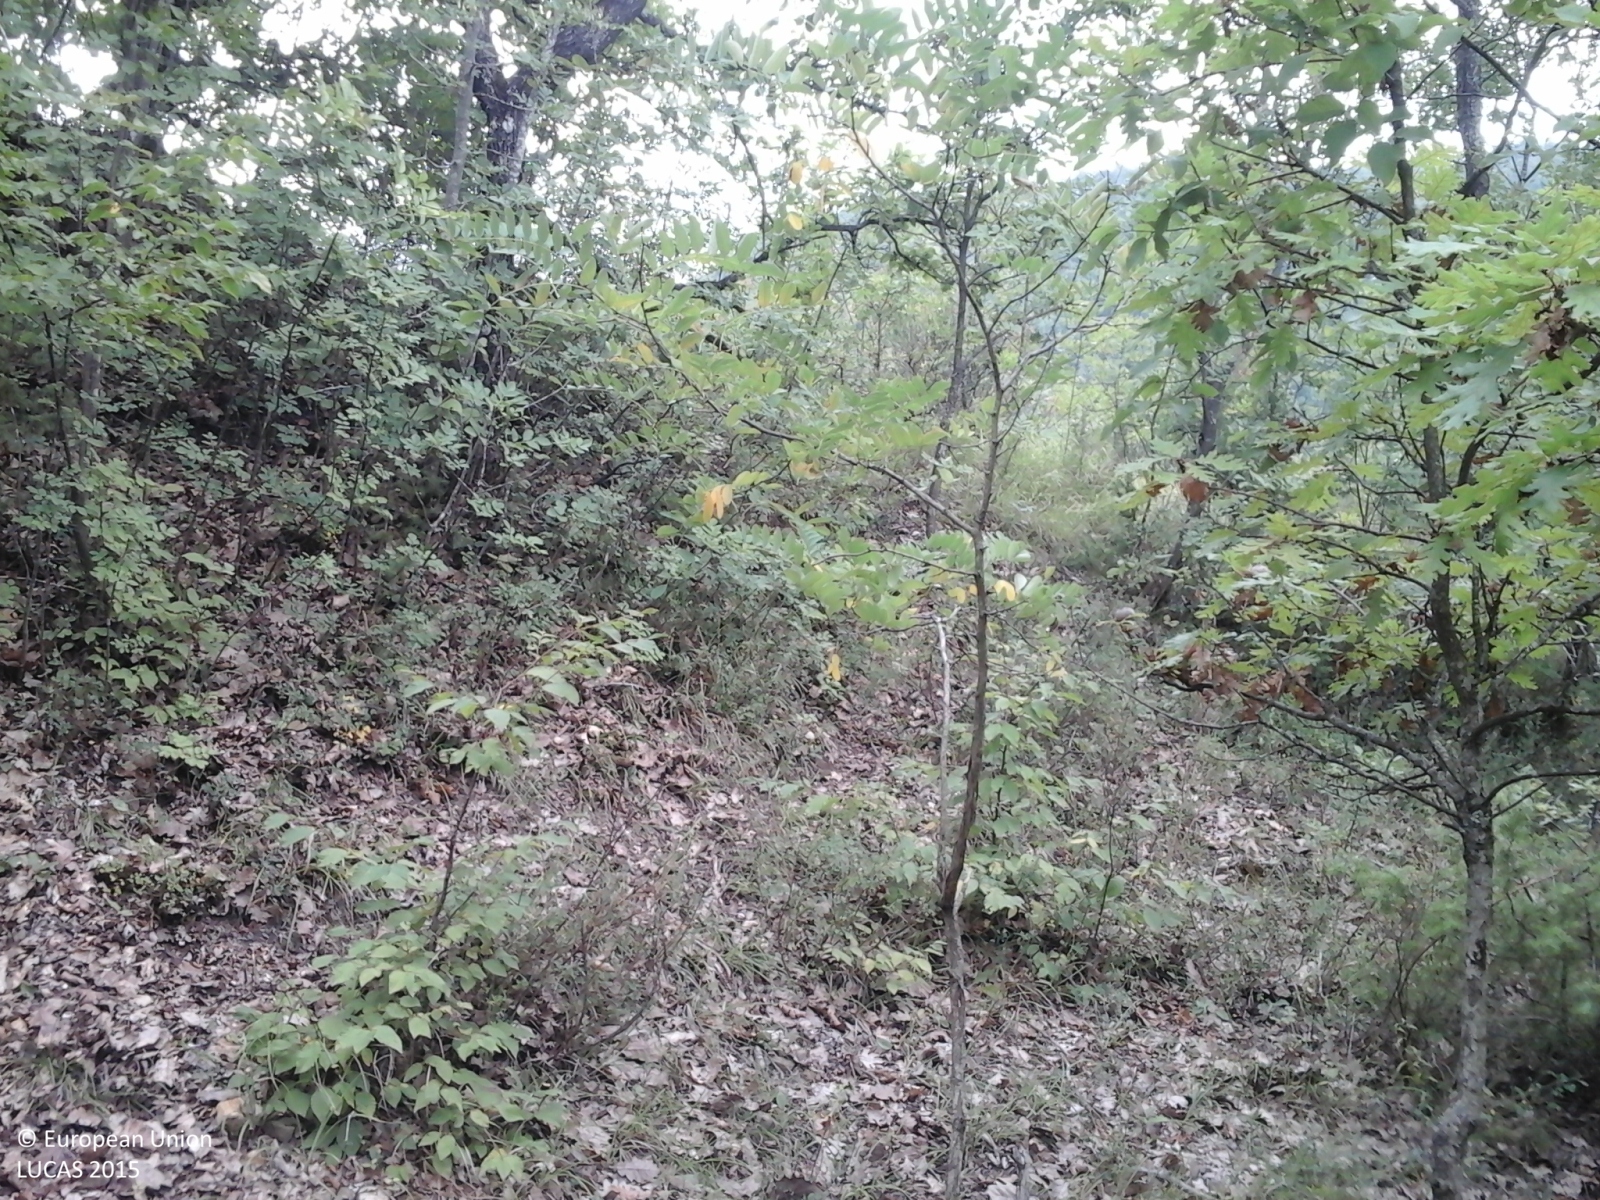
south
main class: Woodland
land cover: Broadleaved woodland
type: thermophilous deciduous forest
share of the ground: > 75 %
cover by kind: broadleaved forest trees 95 %, unconsolidated bare surface 5 %
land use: Forestry
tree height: < 5 m
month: August
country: IT
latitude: 44.8162
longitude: 9.1797
